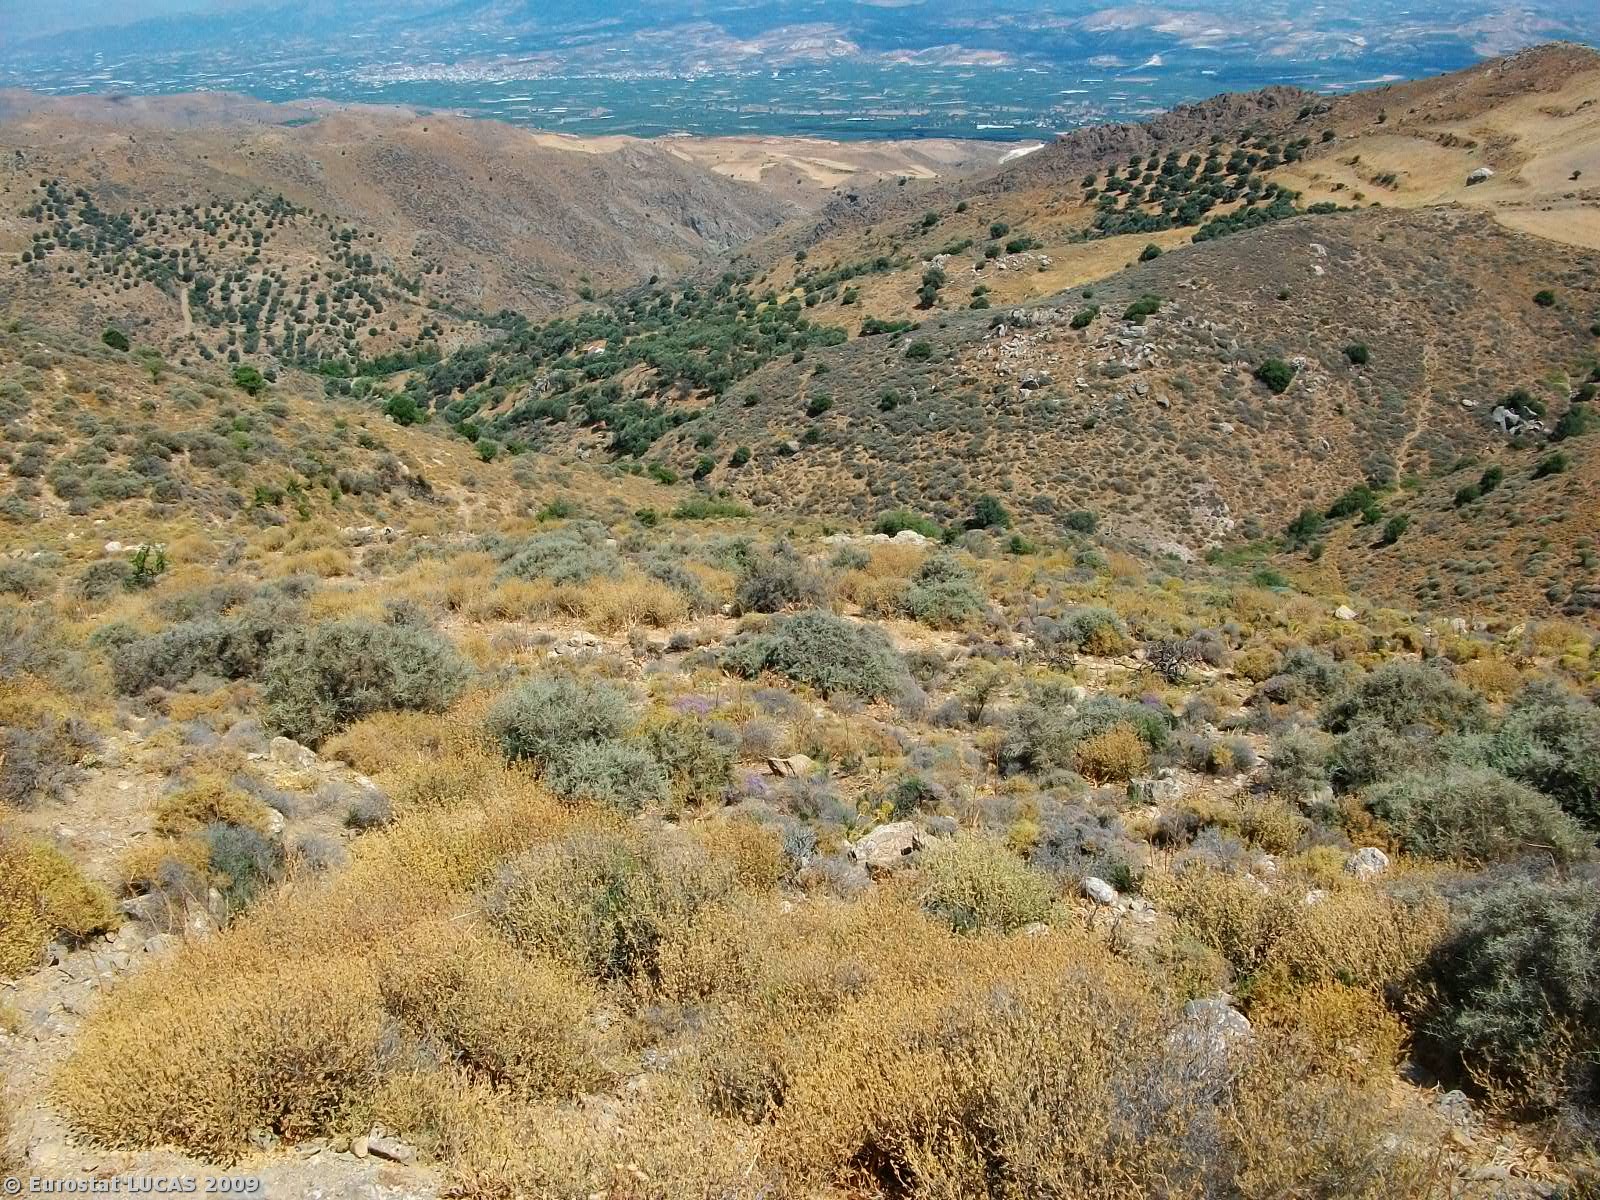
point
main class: Shrubland
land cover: Shrubland without tree cover
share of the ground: > 75 %
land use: Agriculture (excluding fallow land and kitchen gardens)
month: July
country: GR
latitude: 34.9763
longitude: 24.9355
